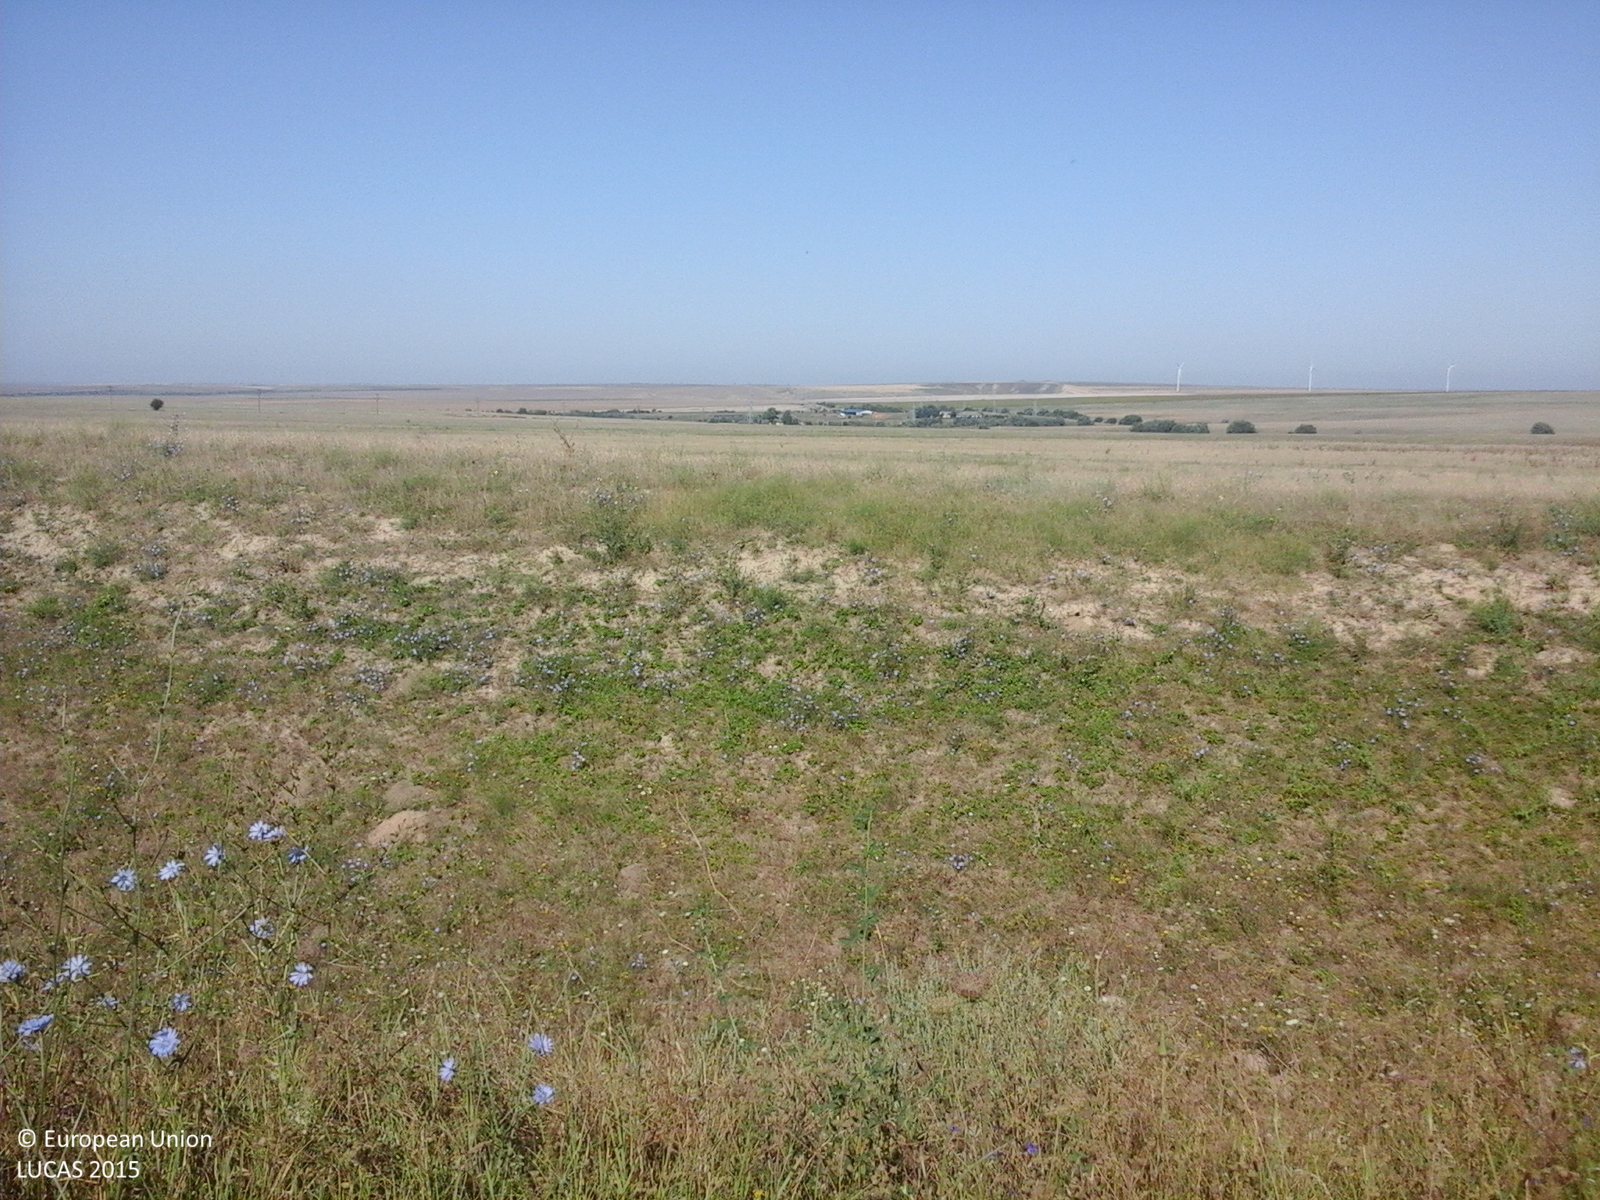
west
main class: Cropland
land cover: Maize
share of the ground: > 75 %
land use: Agriculture (excluding fallow land and kitchen gardens)
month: August
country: RO
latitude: 44.6595
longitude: 28.2133
